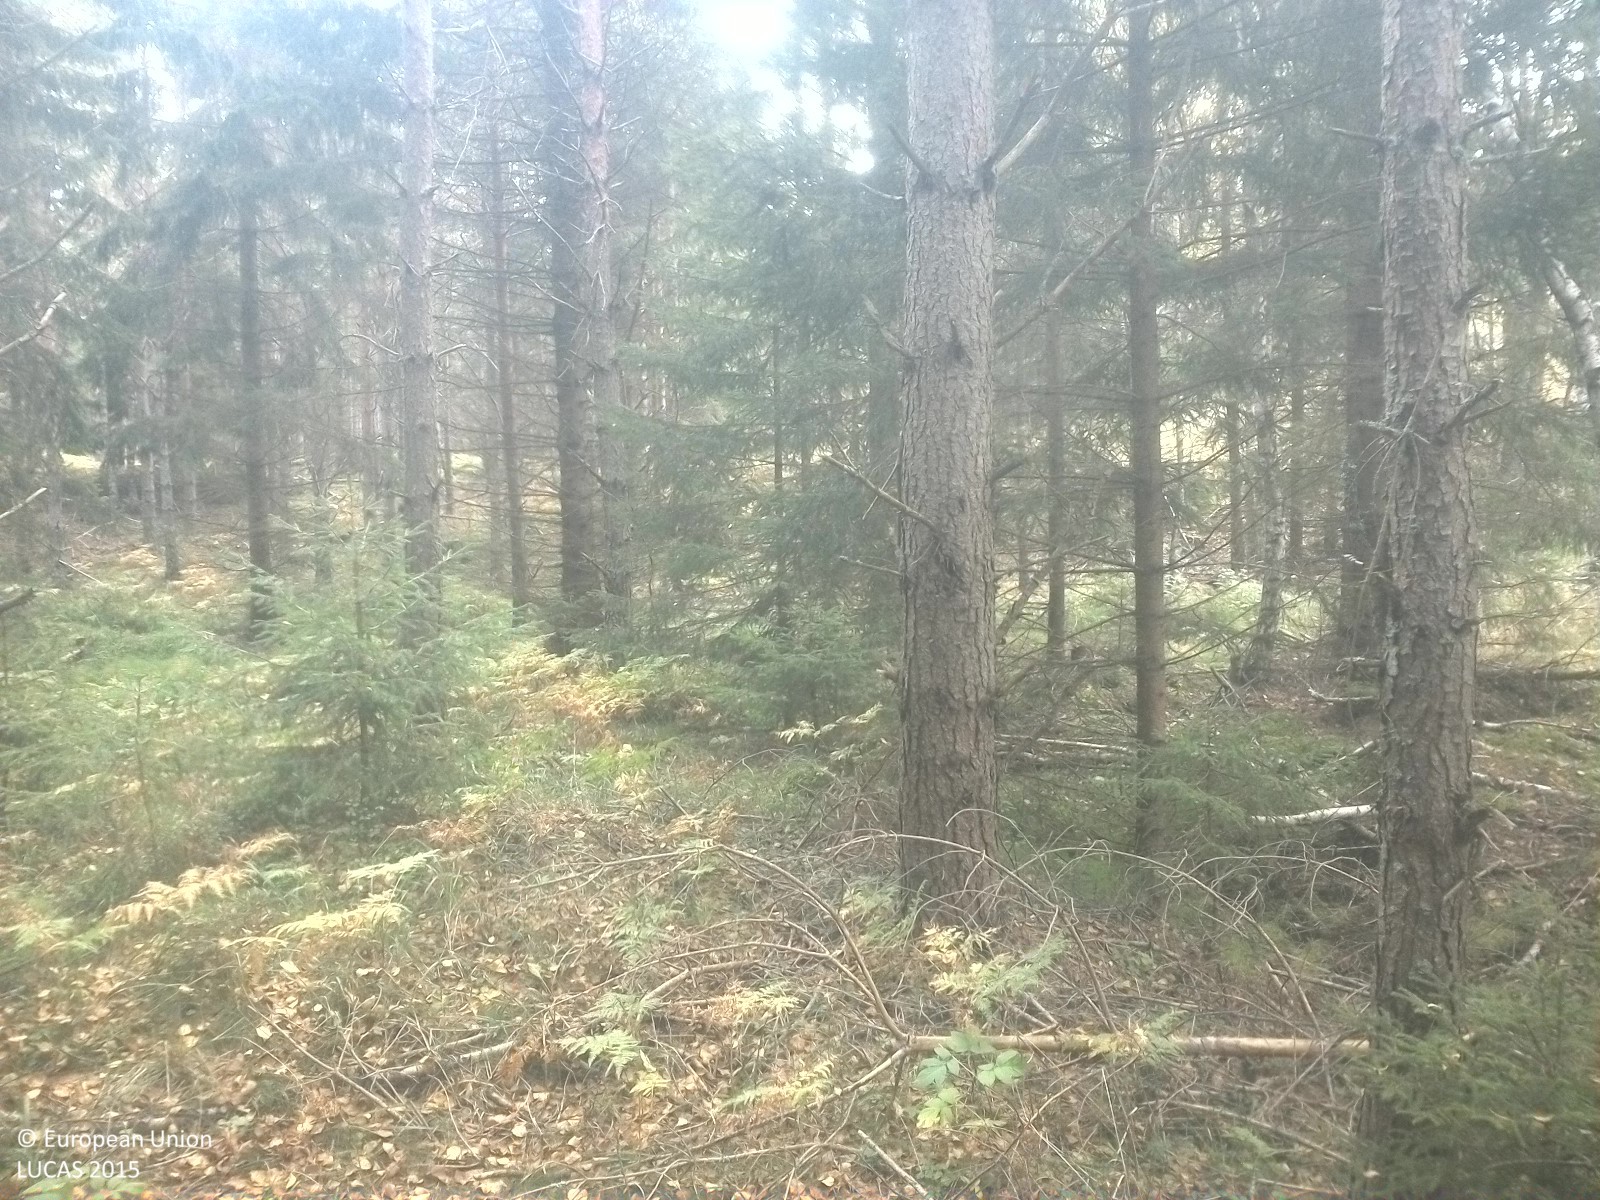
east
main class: Woodland
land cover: Pine dominated mixed woodland
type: boreal forest
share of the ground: 25 - 50 %
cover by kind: herbaceous plants 55 %, coniferous forest trees 20 %, lichens and mosses 15 %, broadleaved forest trees 10 %
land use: Forestry
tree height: > 5 m
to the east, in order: Pine dominated mixed woodland; Rivers and streams; Pine dominated mixed woodland; Pine dominated coniferous woodland; Spruce dominated mixed woodland; Pine dominated coniferous woodland
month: September
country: SE
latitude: 58.6773
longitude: 16.8432
